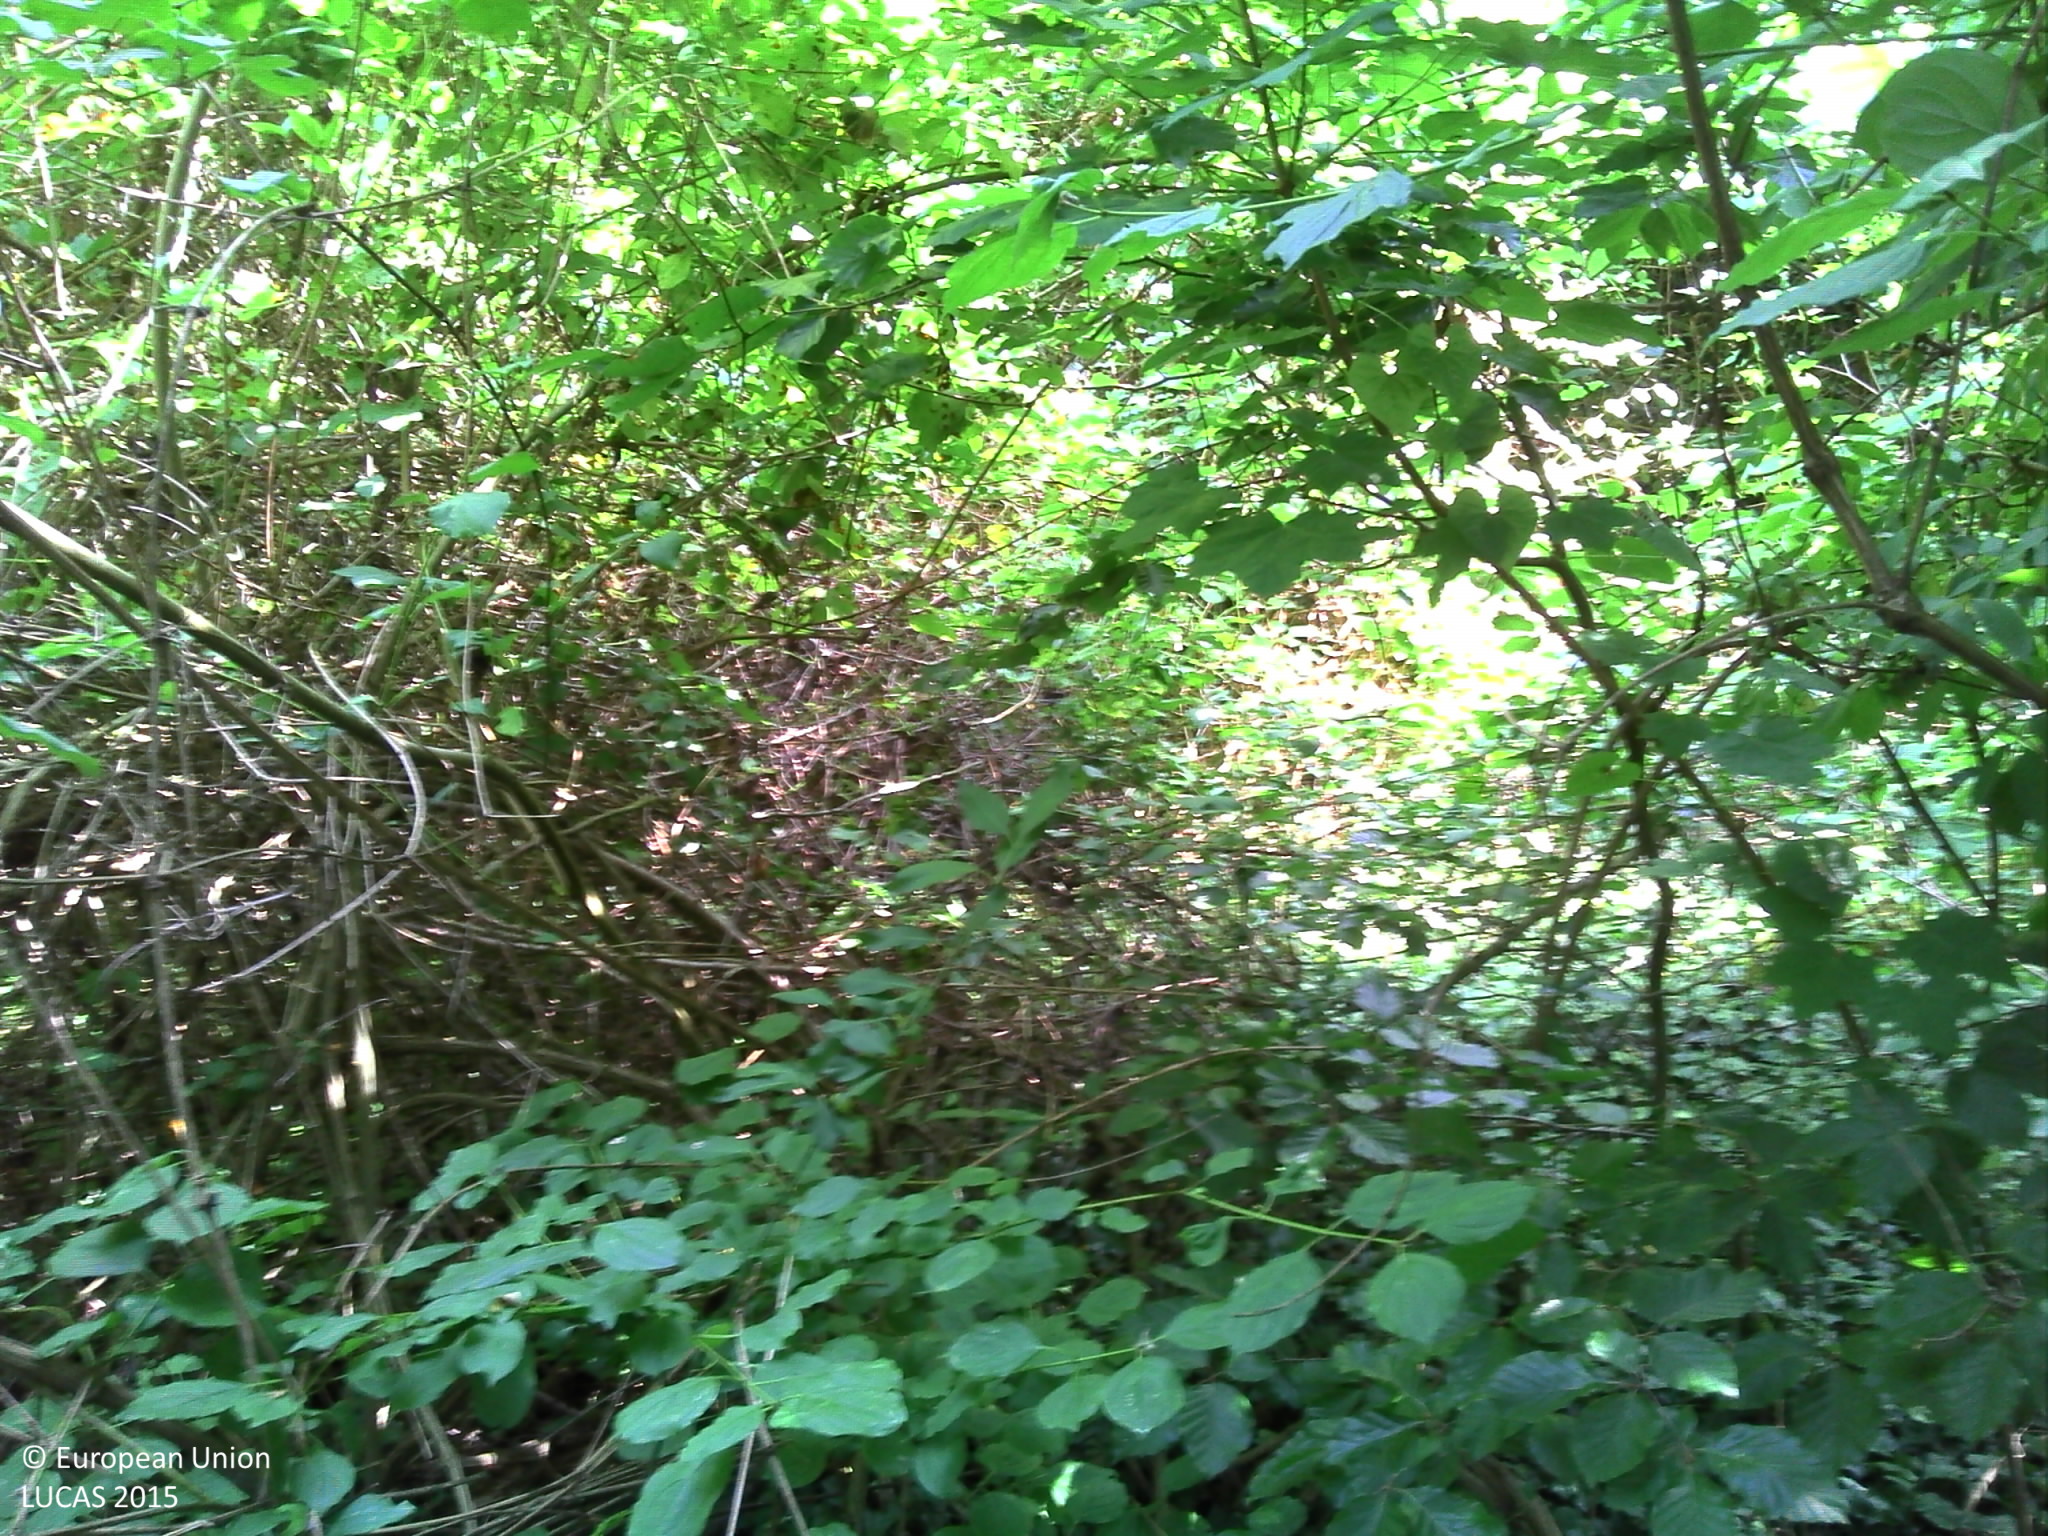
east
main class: Woodland
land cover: Broadleaved woodland
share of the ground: > 75 %
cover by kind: broadleaved forest trees 90 %, herbaceous plants 5 %, lichens and mosses 5 %
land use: Semi-natural and natural areas not in use
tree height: < 5 m
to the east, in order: Broadleaved woodland; Dry stone walls; Broadleaved woodland; Grass margins; Common wheat; Artificial constructions in urban areas
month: July
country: FR
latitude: 48.6712
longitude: 5.9395
